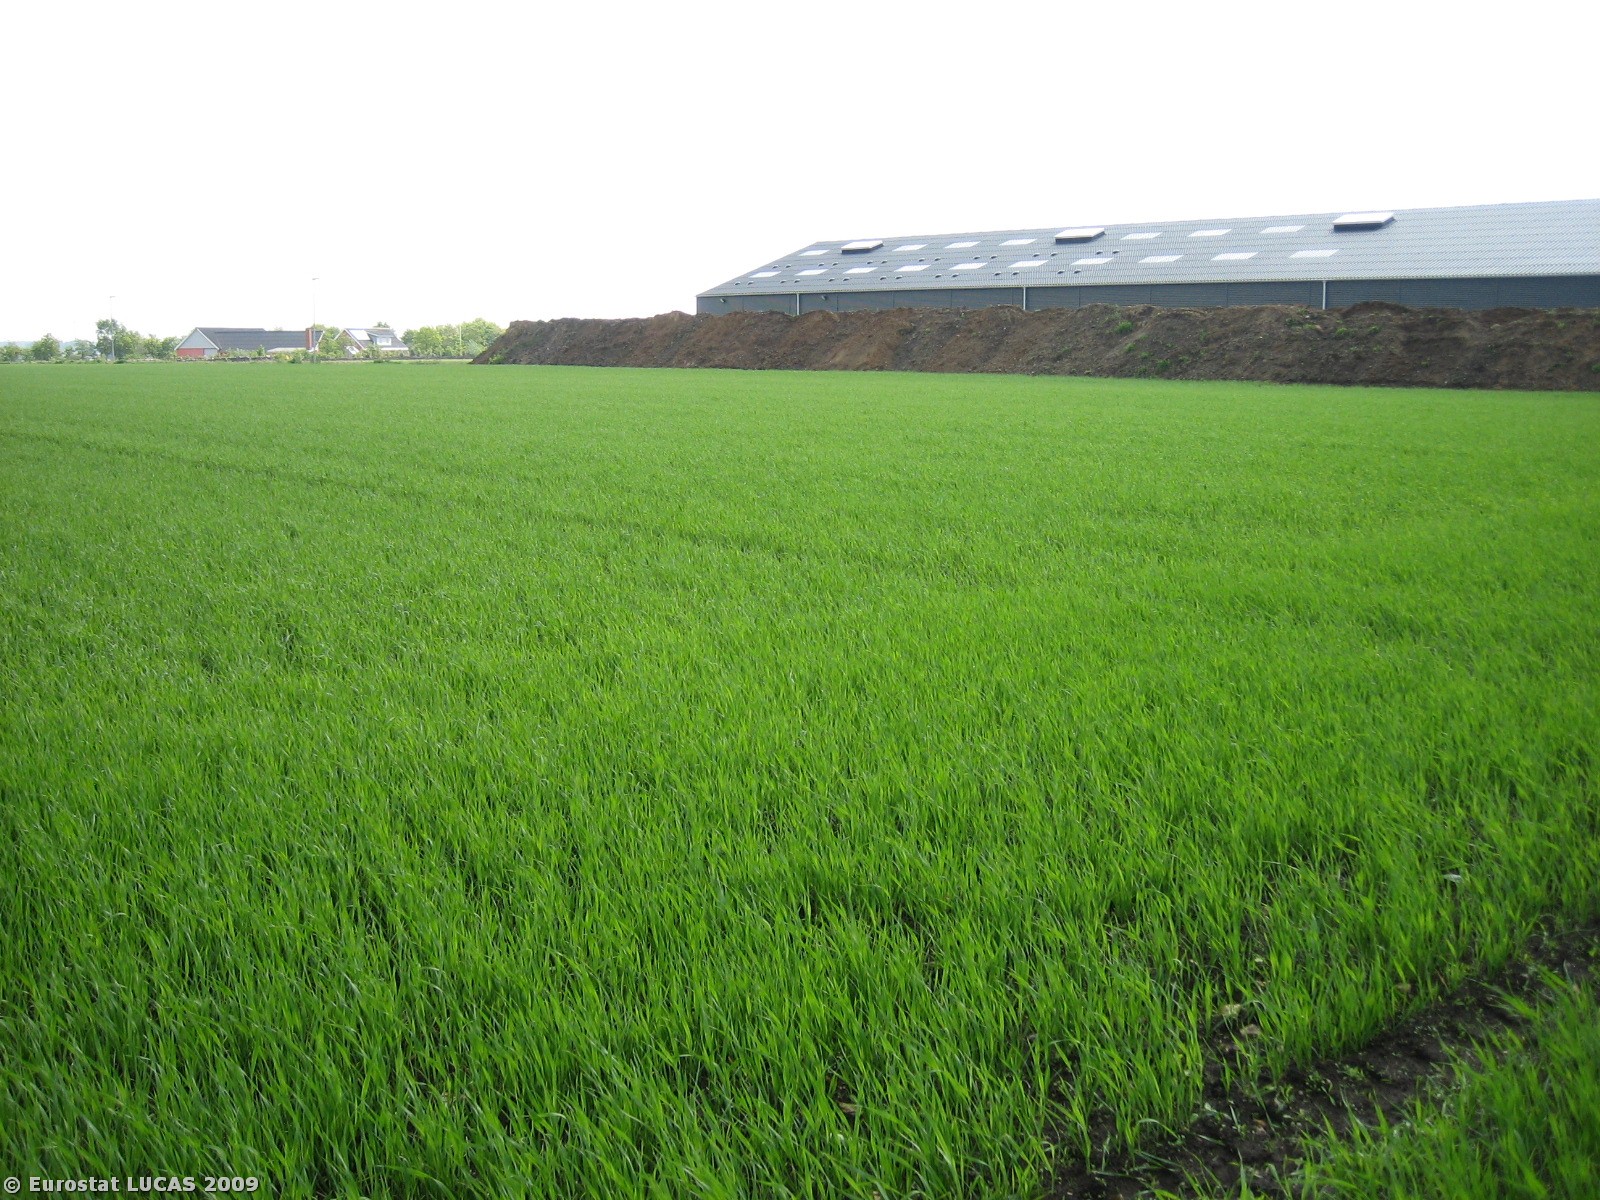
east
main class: Cropland
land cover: Oats
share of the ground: > 75 %
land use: Agriculture (excluding fallow land and kitchen gardens)
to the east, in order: Oats; Bare land; Artificial constructions in urban areas; Paved roads, cycling and walking lanes; Grass margins; Rye
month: May
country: DK
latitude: 56.2540
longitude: 8.7909
